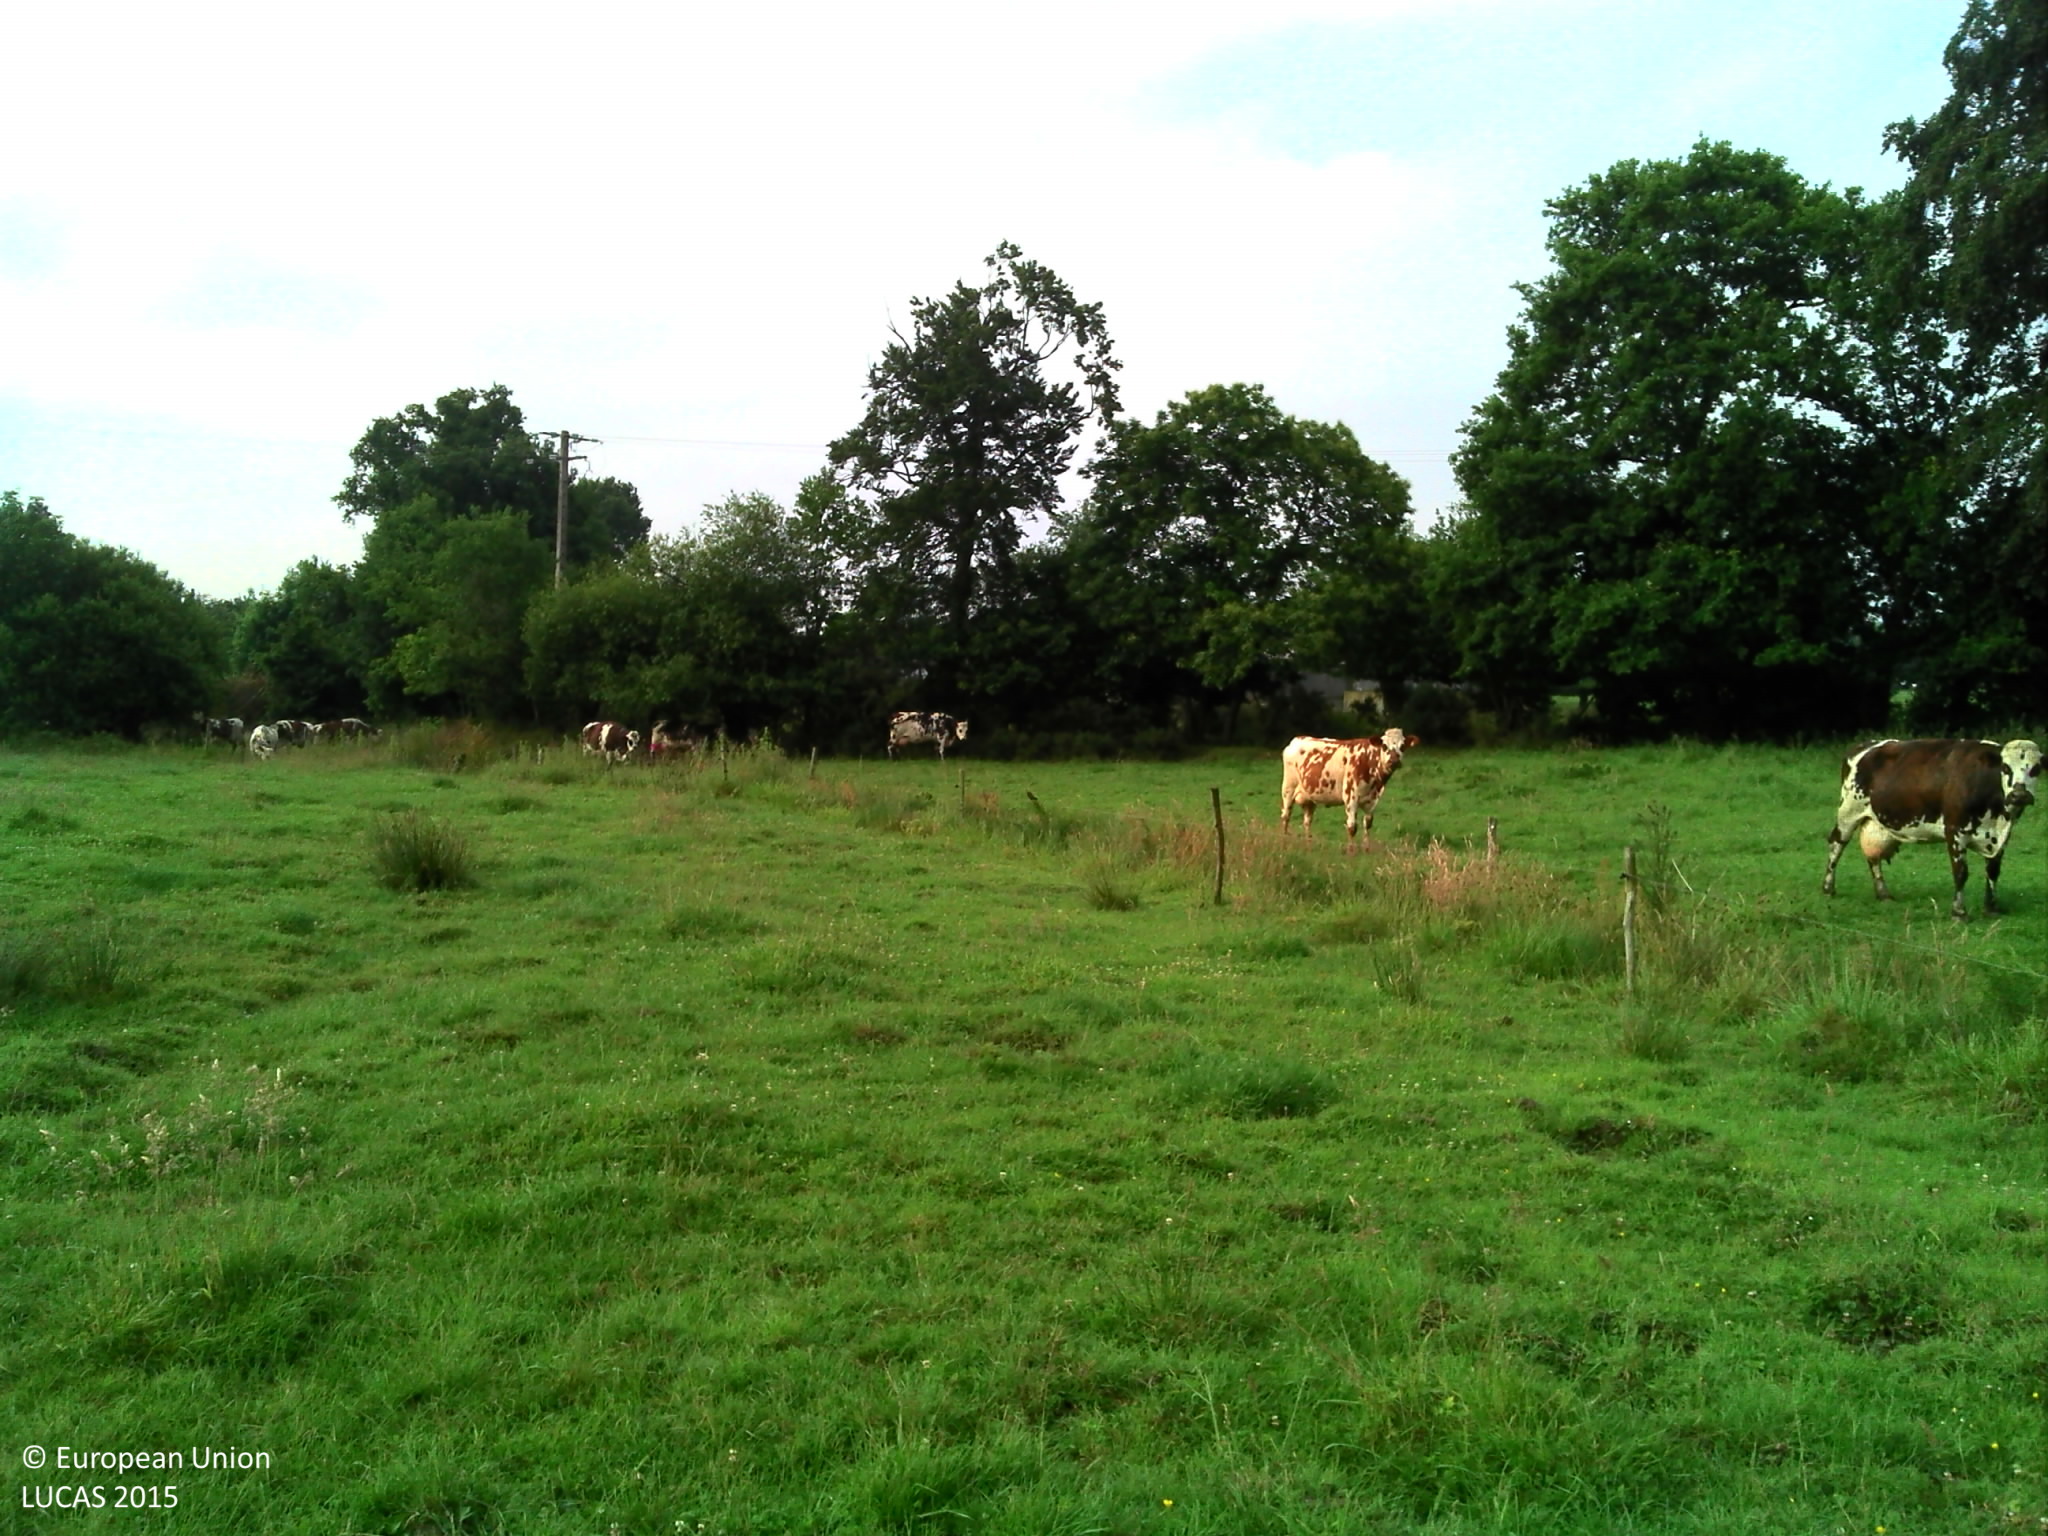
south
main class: Grassland
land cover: Grassland without tree/shrub cover
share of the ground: > 75 %
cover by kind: herbaceous plants 100 %
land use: Agriculture (excluding fallow land and kitchen gardens)
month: June
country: FR
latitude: 48.4094
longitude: -1.7632
